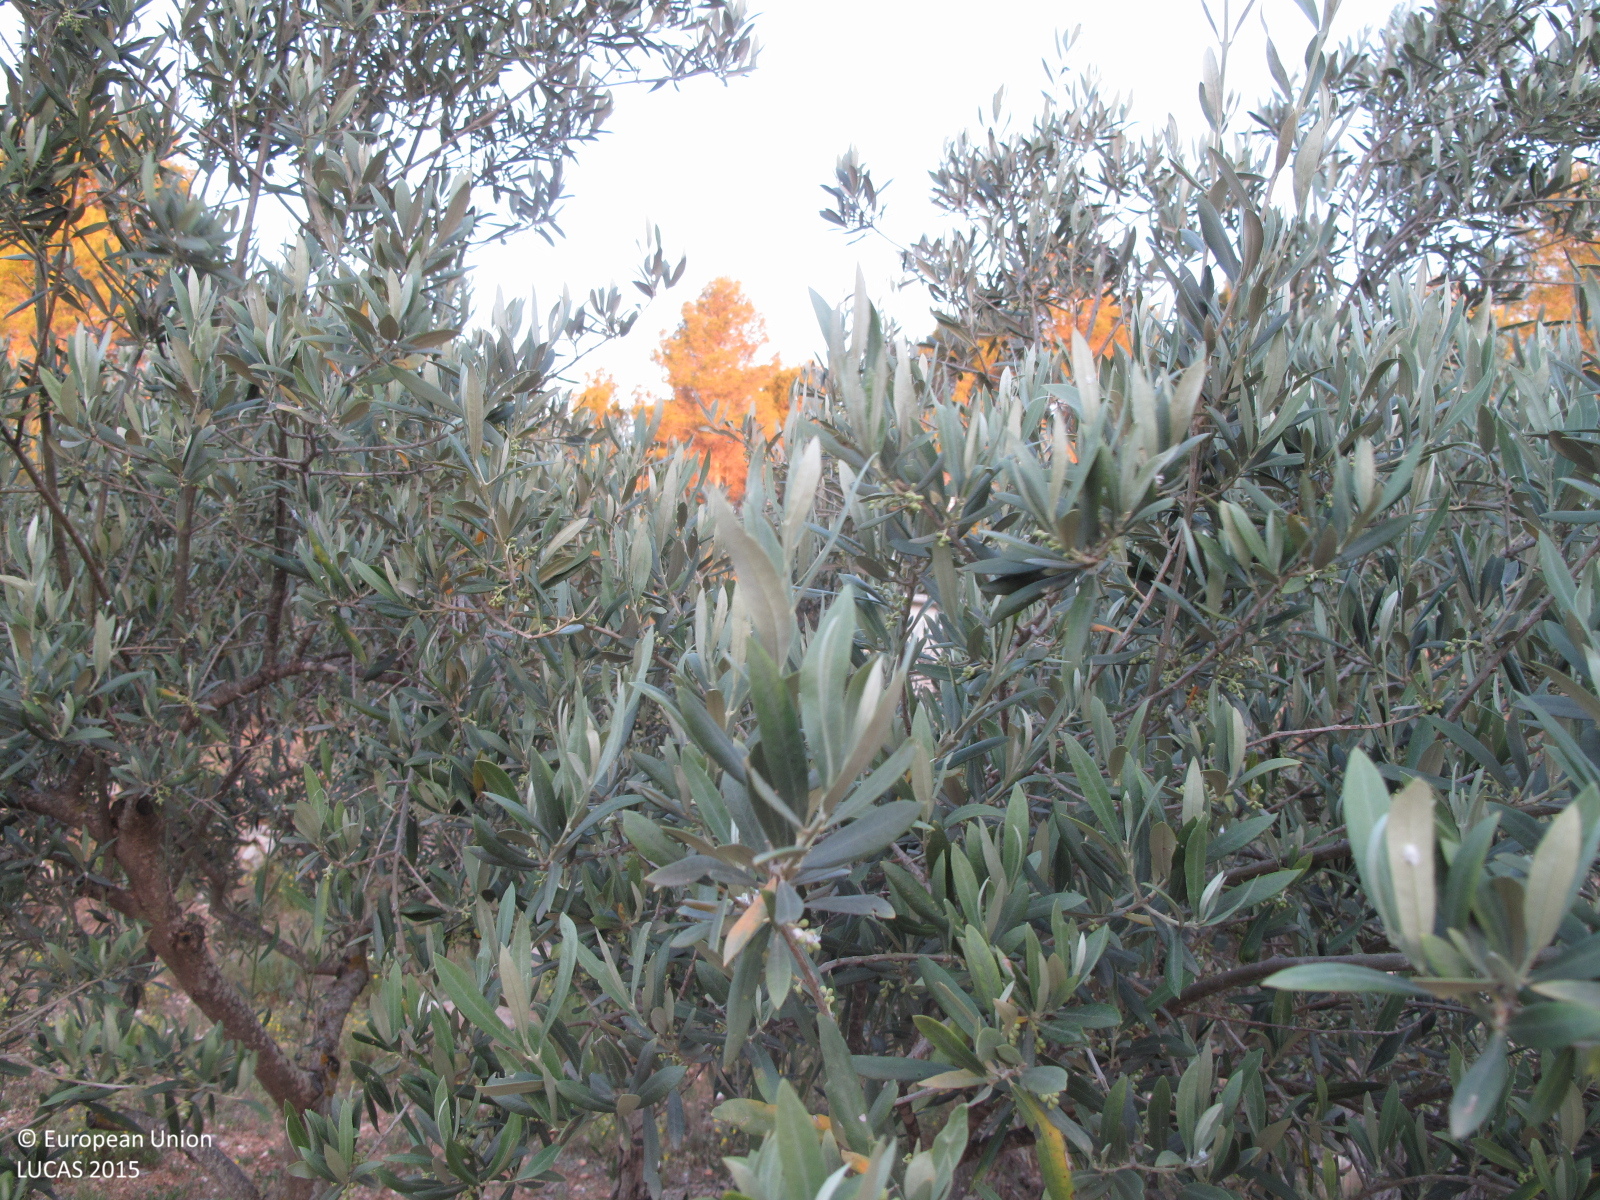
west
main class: Cropland
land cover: Olive groves
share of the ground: 25 - 50 %
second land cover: Spontaneously vegetated surfaces
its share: 25 - 50 %
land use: Agriculture (excluding fallow land and kitchen gardens)
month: May
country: ES
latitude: 38.8878
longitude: -0.7719
